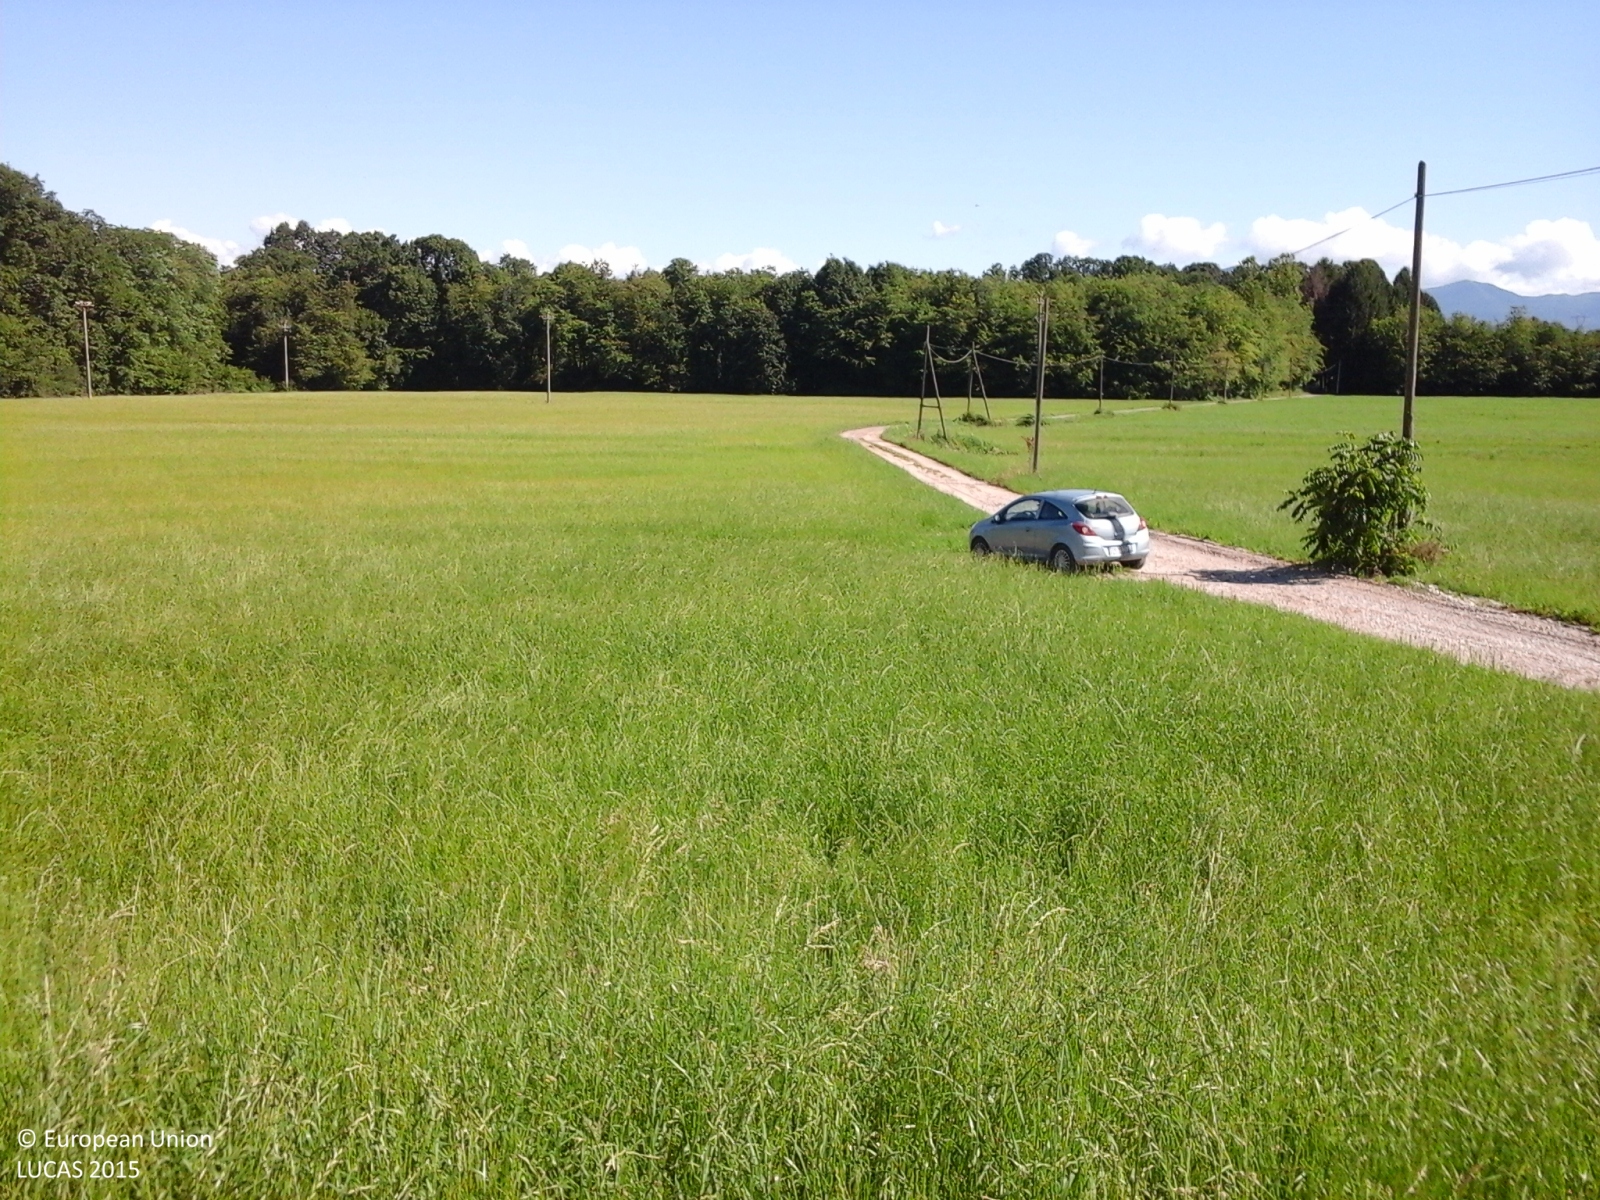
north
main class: Grassland
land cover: Grassland without tree/shrub cover
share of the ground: > 75 %
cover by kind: herbaceous plants 100 %
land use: Agriculture (excluding fallow land and kitchen gardens)
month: June
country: IT
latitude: 45.7838
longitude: 8.6258
